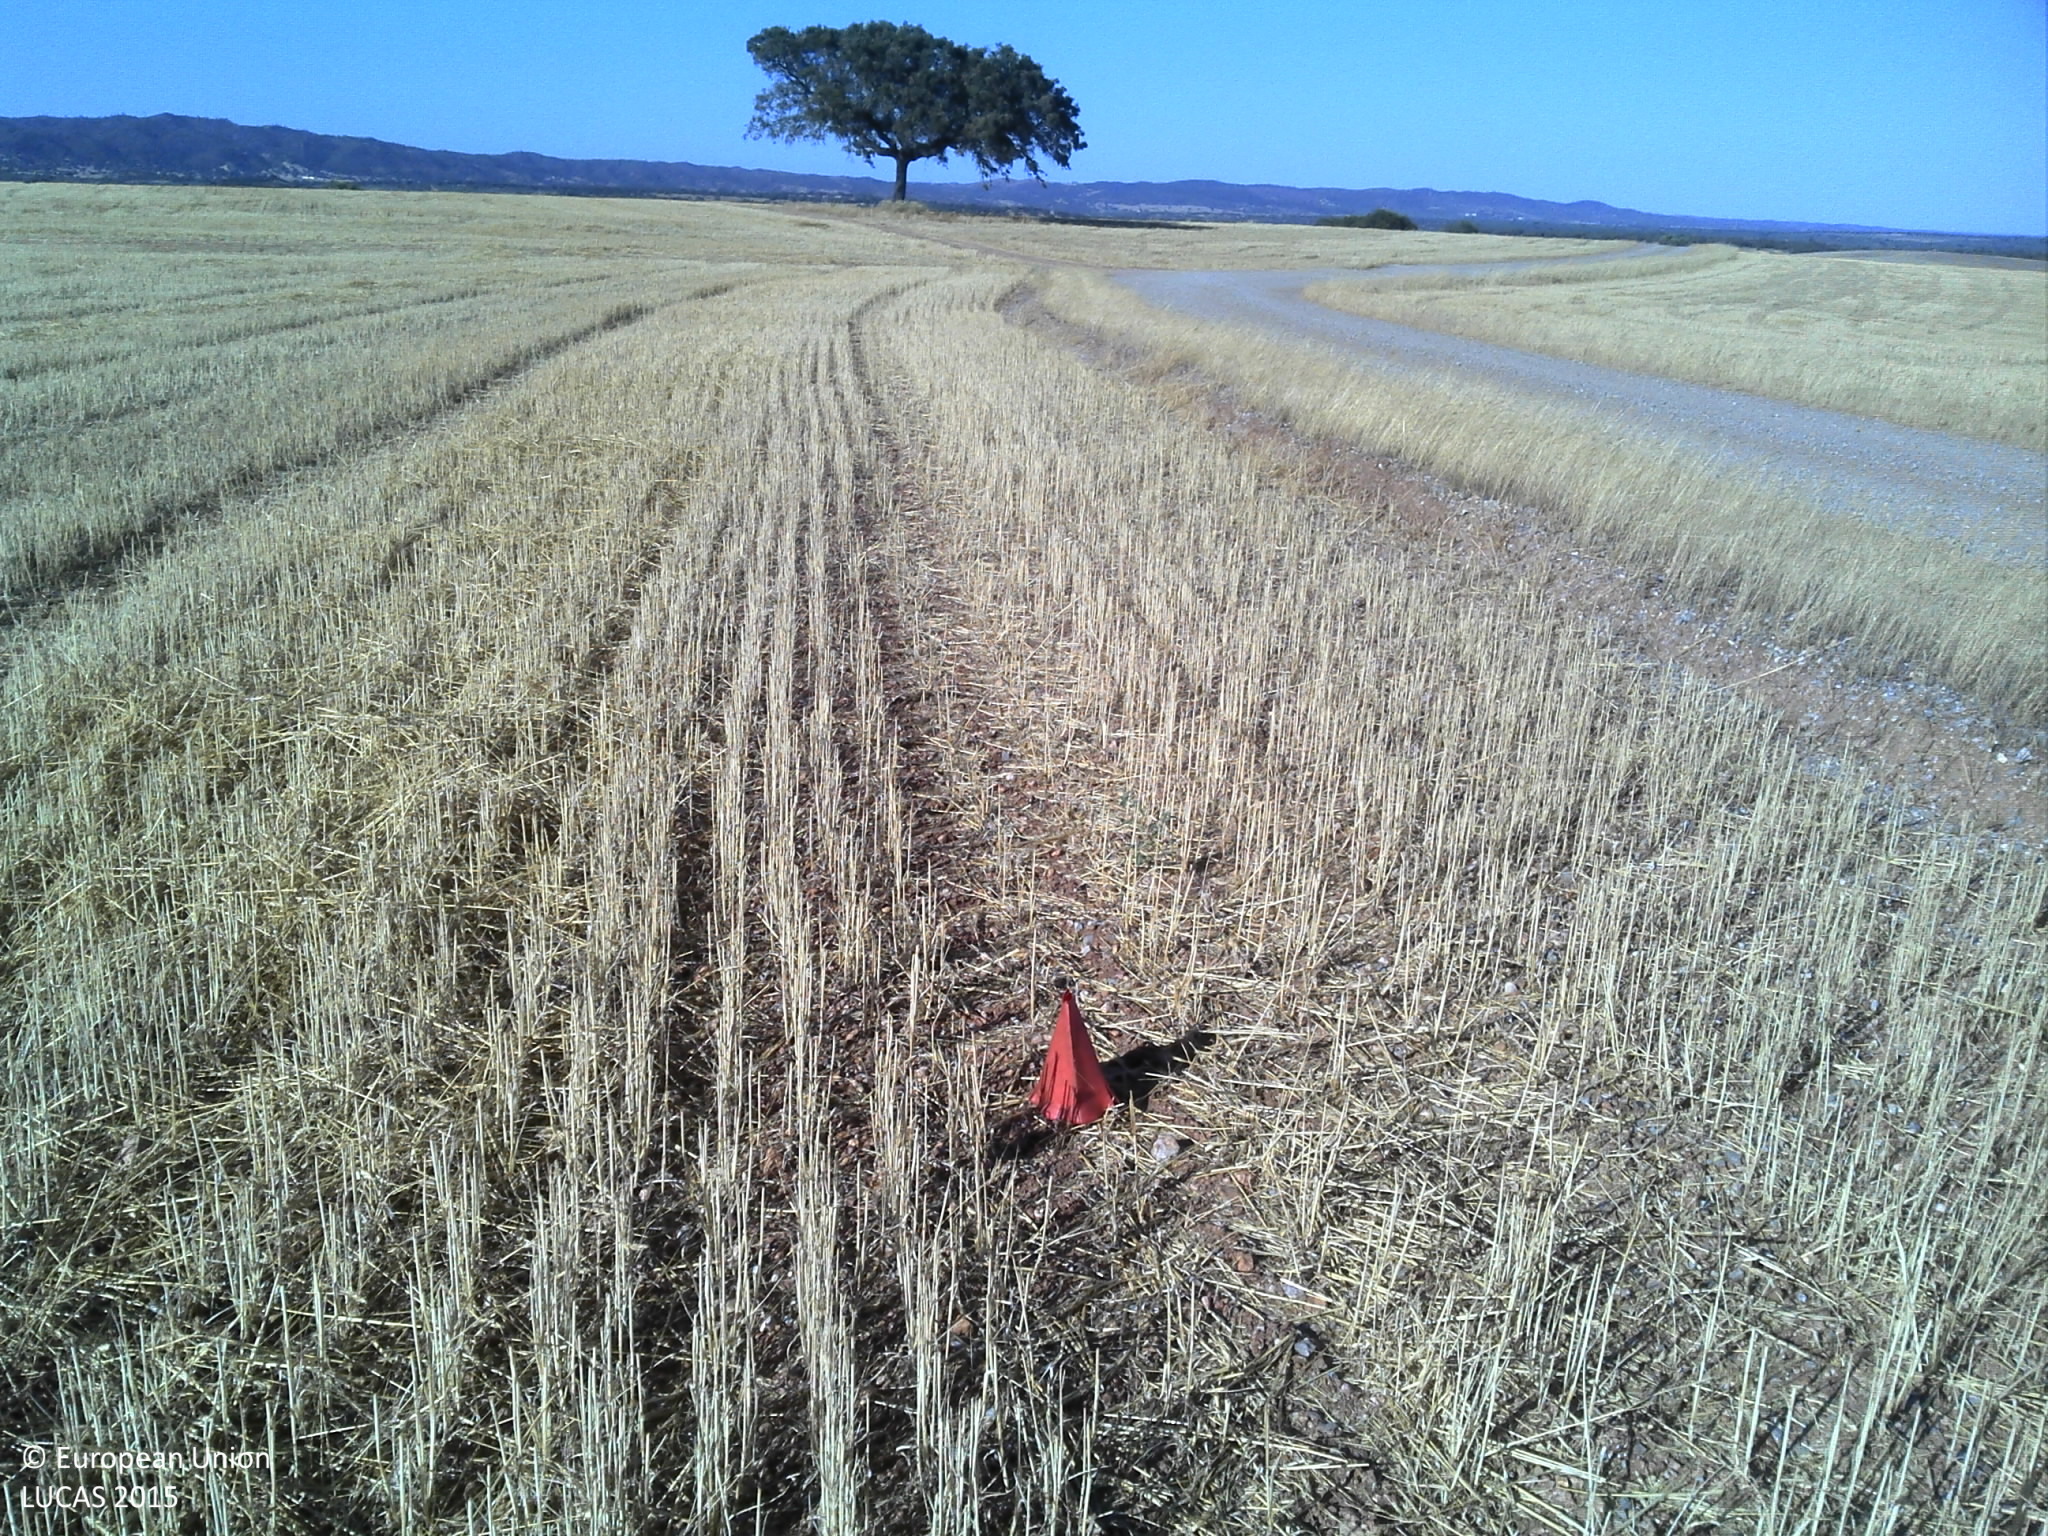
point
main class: Cropland
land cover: Common wheat
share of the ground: 25 - 50 %
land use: Agriculture (excluding fallow land and kitchen gardens)
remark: Harvested field
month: July
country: PT
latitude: 38.1351
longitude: -7.6520
